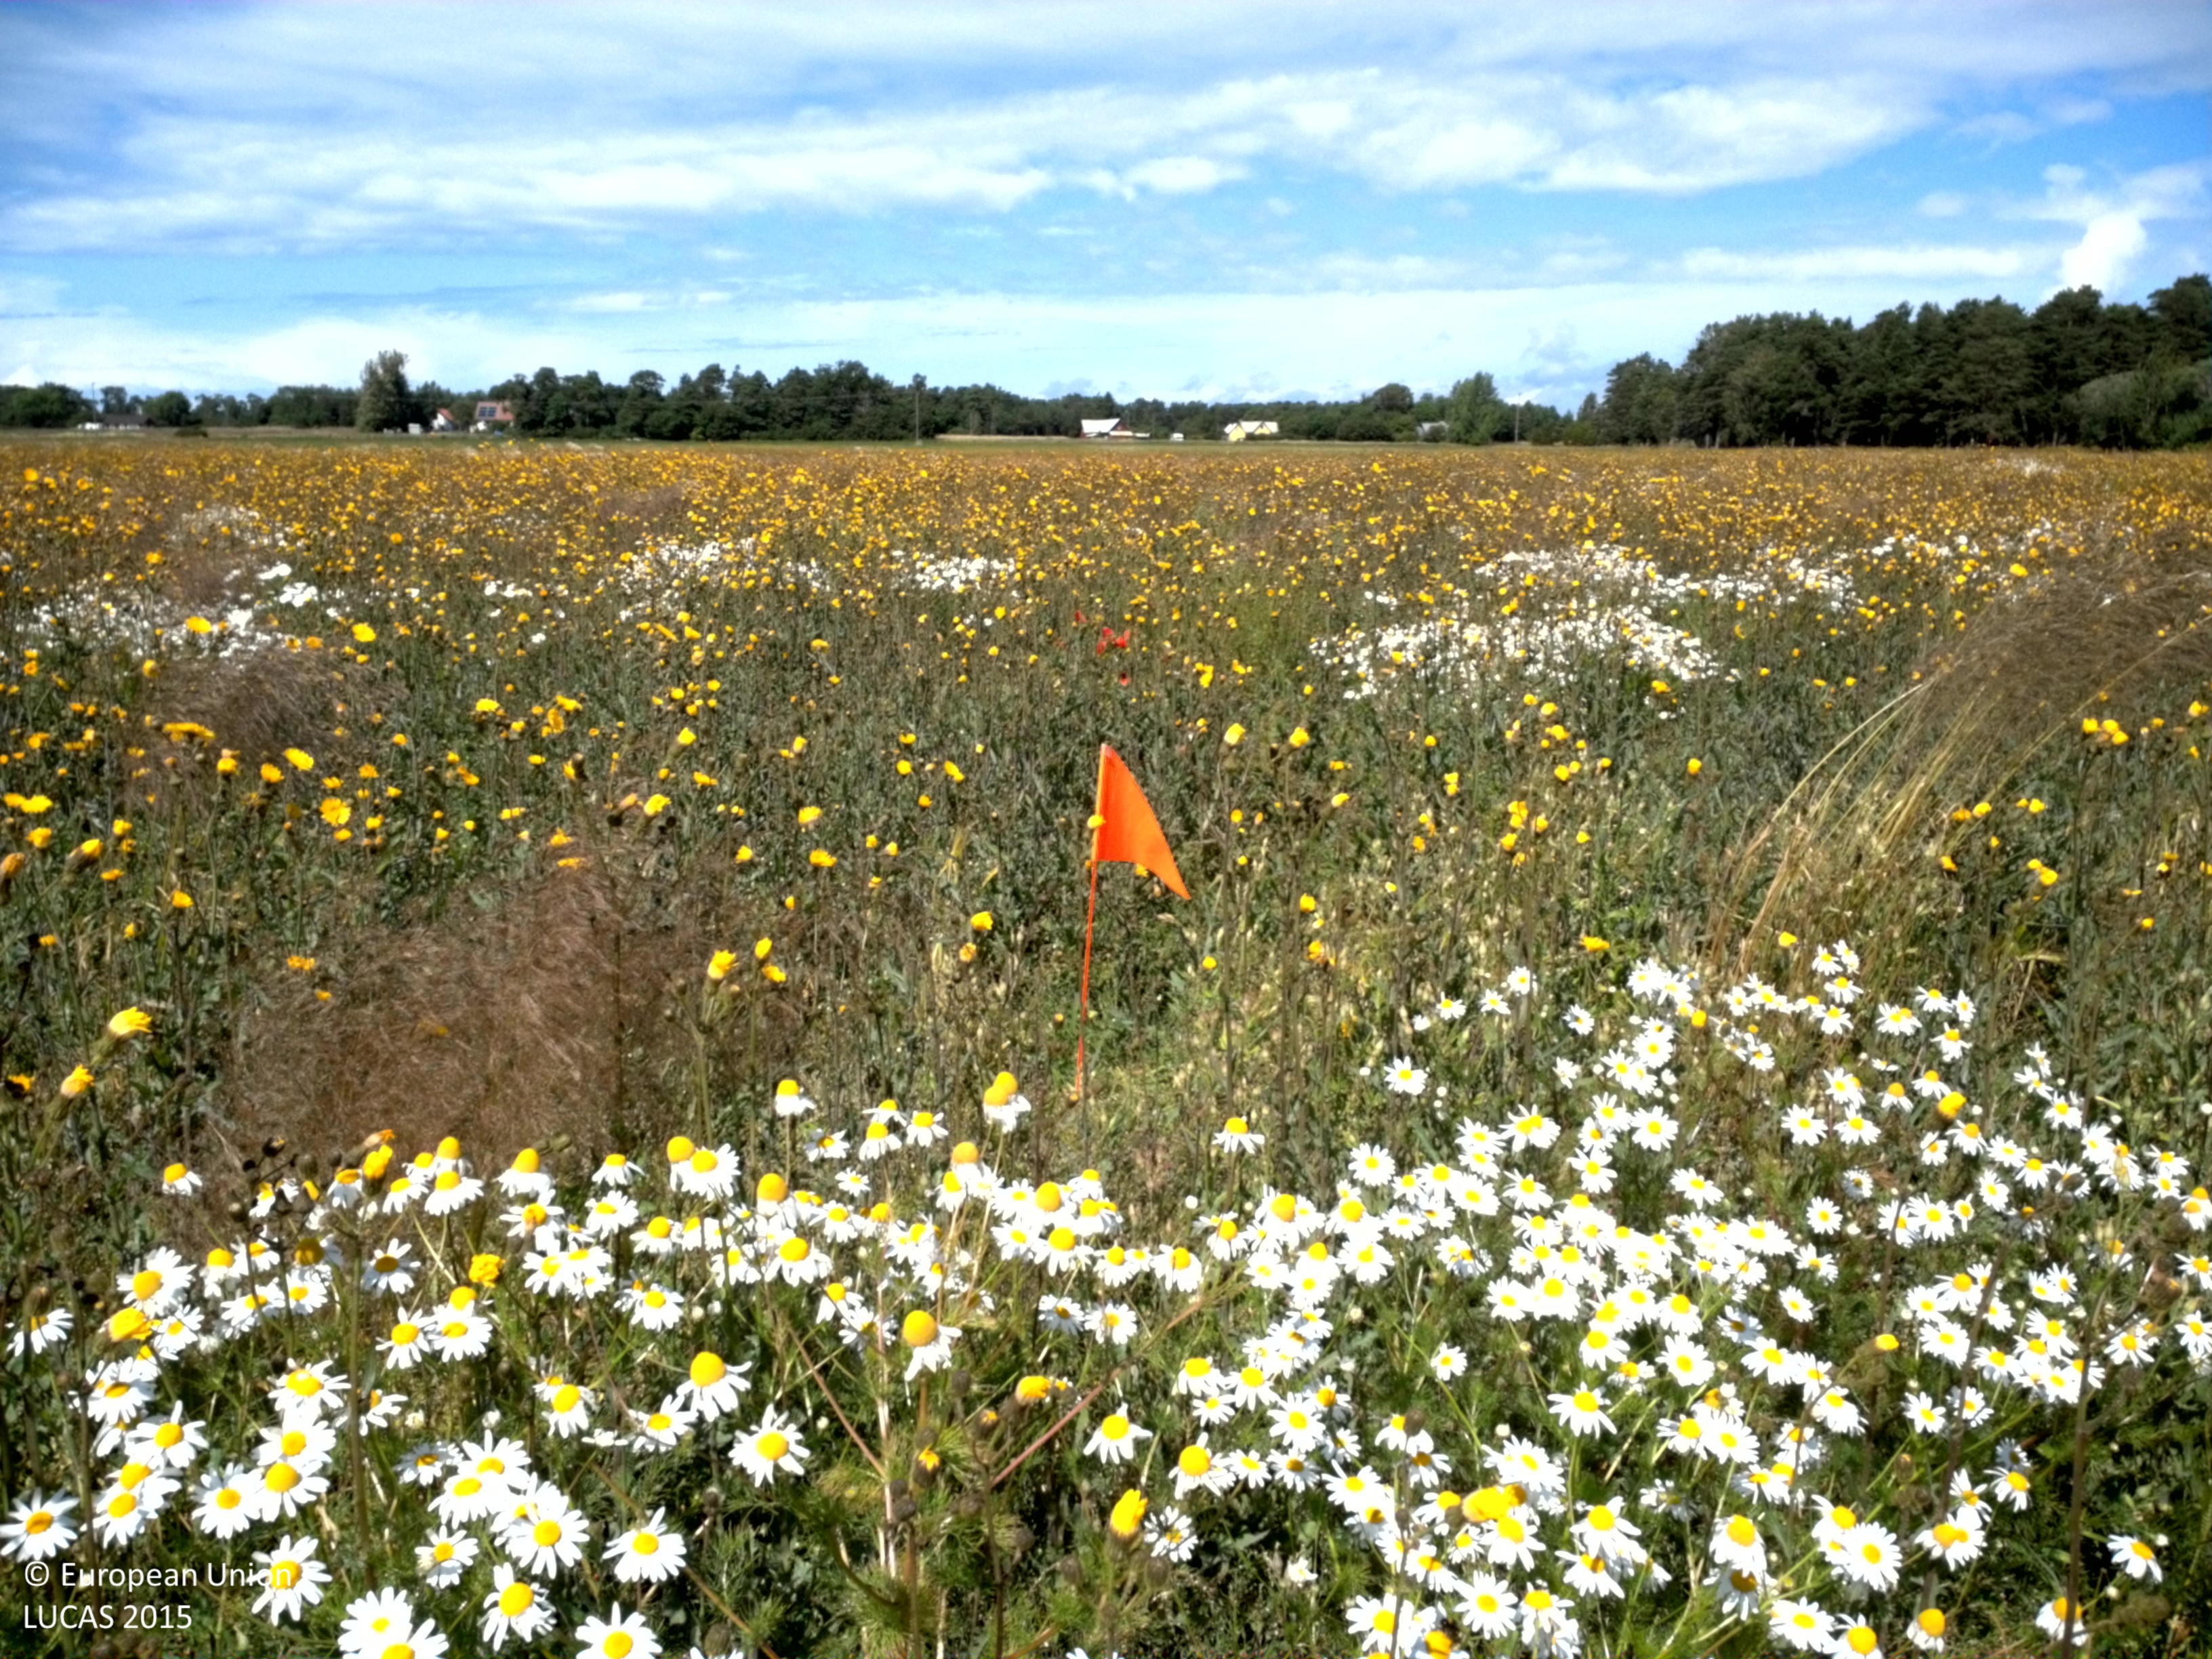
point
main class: Cropland
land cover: Temporary grasslands
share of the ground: > 75 %
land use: Agriculture (excluding fallow land and kitchen gardens)
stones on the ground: < 10 %
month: July
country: SE
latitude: 57.2823
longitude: 18.1856
